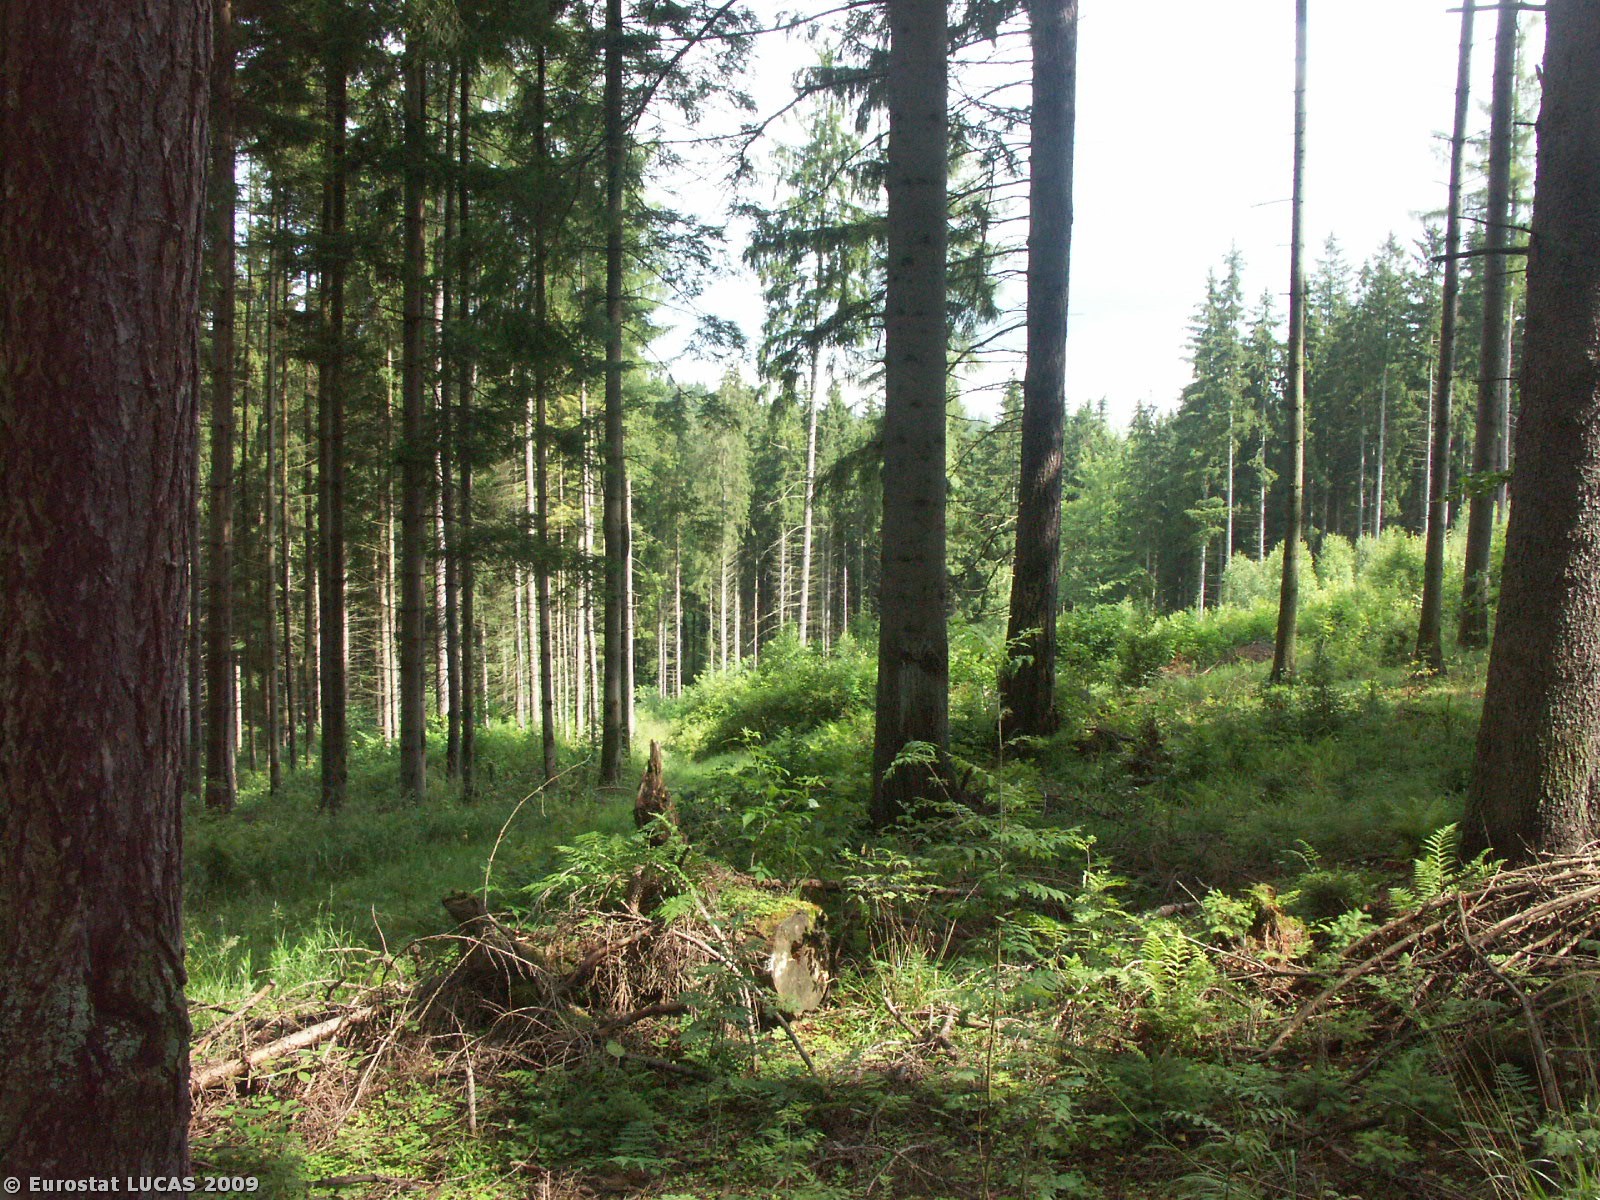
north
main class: Woodland
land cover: Coniferous woodland
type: hemiboreal forest and nemoral coniferous forest and mixed broadleaved-coniferous forest
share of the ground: > 75 %
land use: Forestry
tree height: > 5 m
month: July
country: CZ
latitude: 49.9429
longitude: 17.4111
